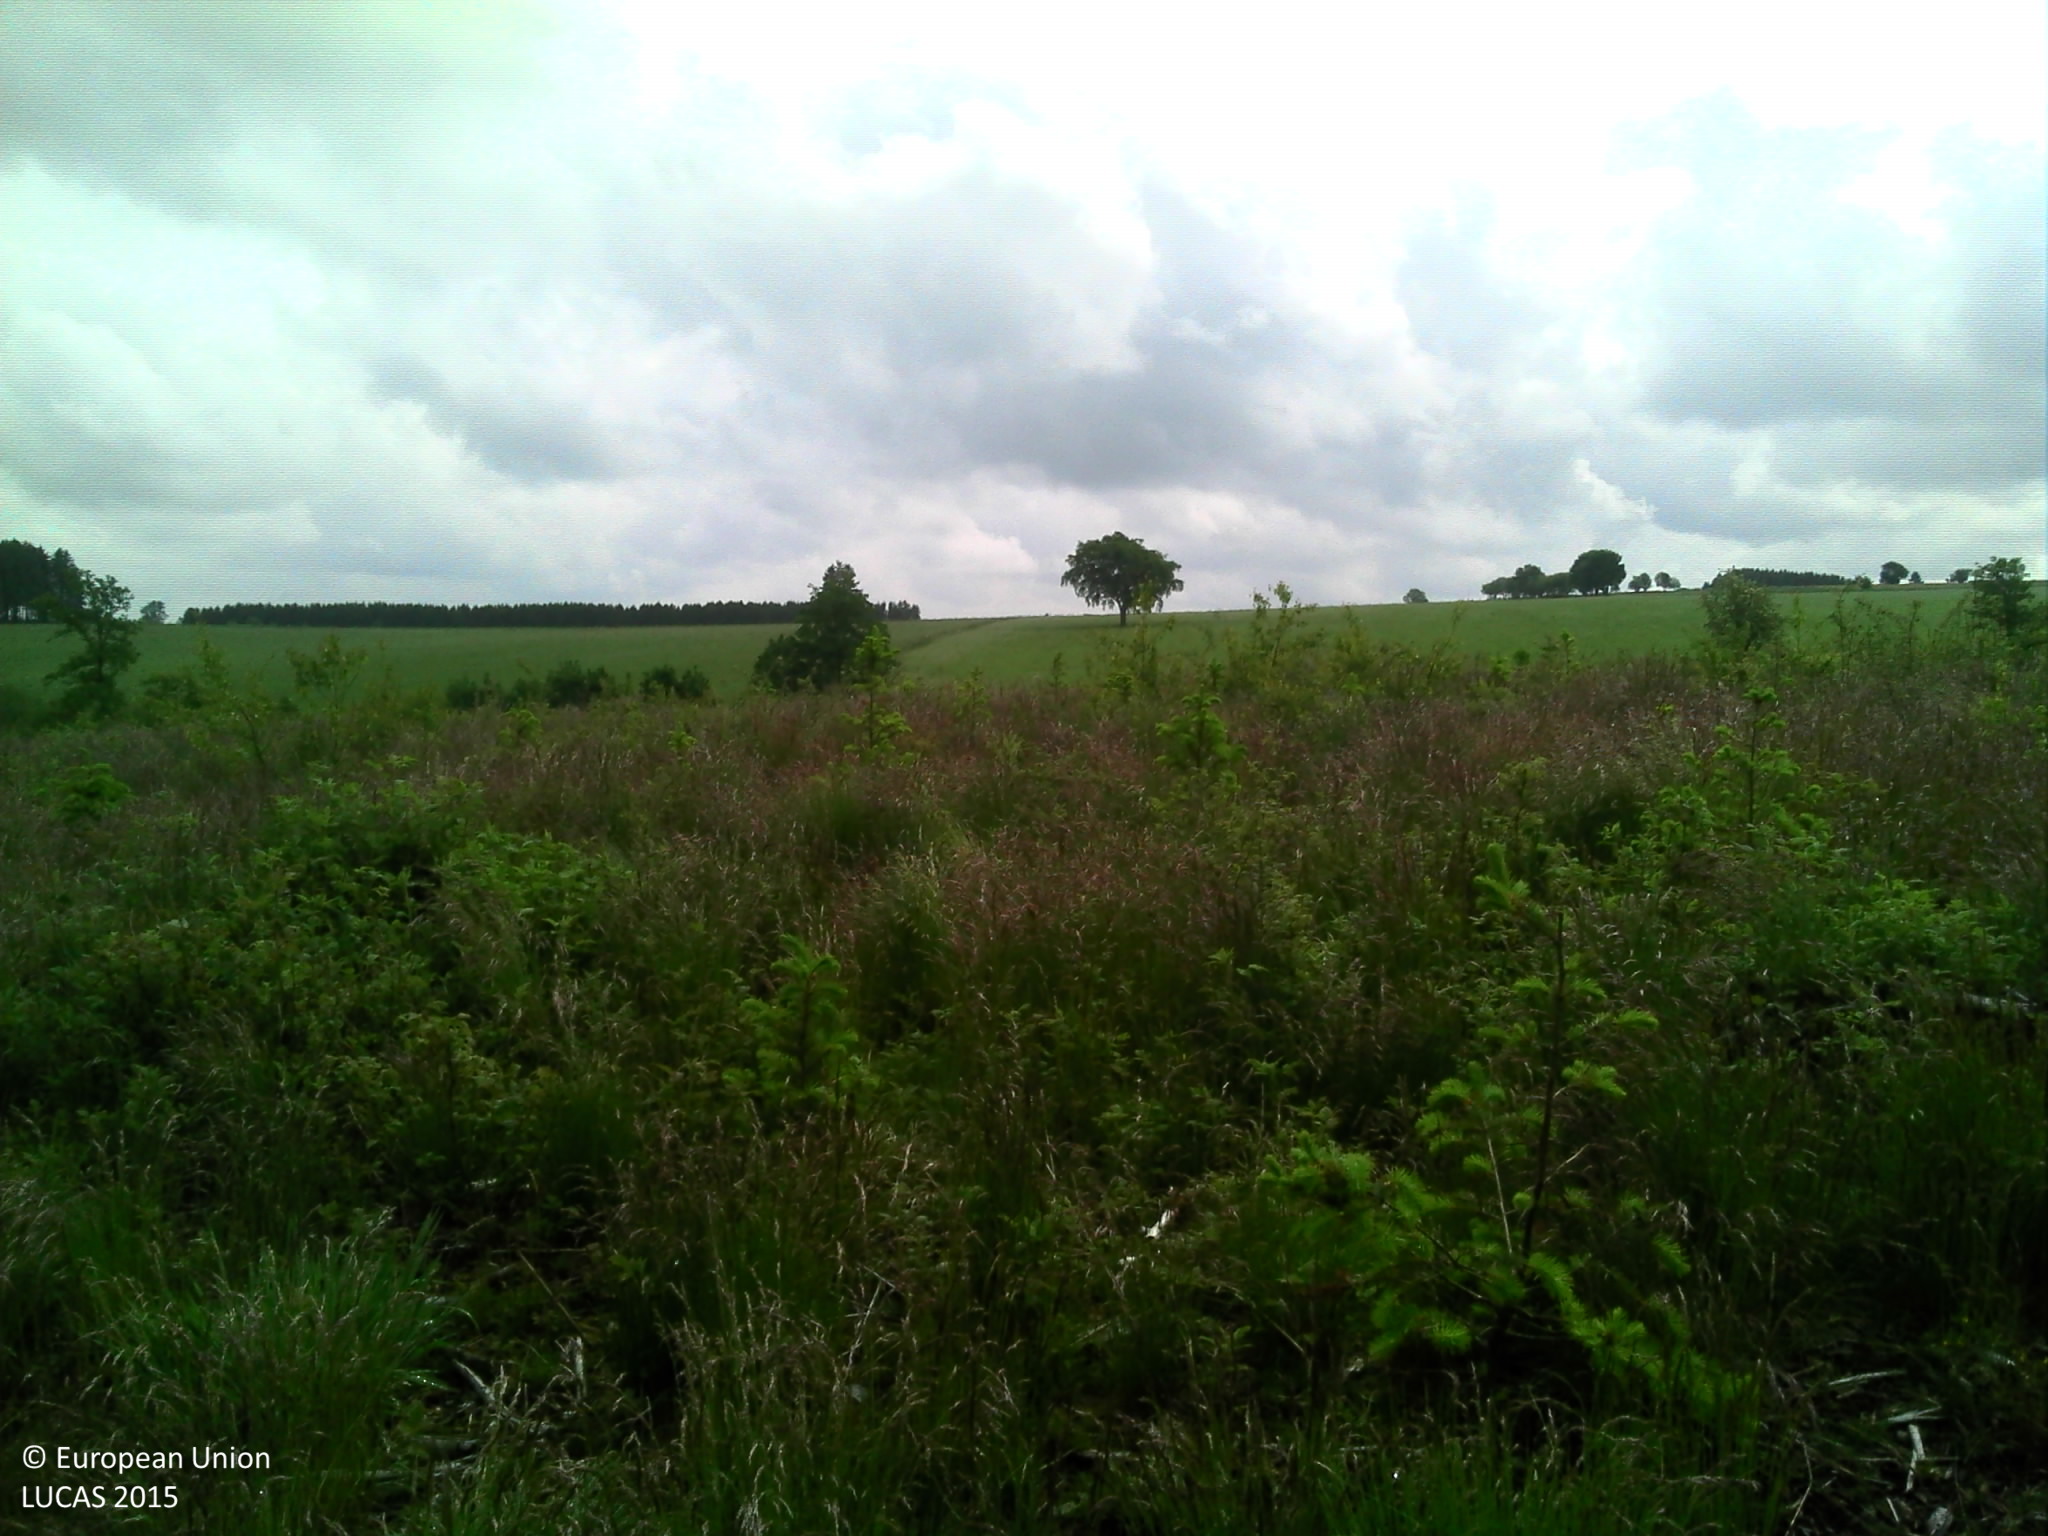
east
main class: Shrubland
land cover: Shrubland without tree cover
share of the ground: > 75 %
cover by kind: shrubs 60 %, herbaceous plants 40 %
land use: Forestry
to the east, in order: Shrubland without tree cover; Grass margins; Tracks; Nurseries; Broadleaved woodland; Grassland with sparse tree/shrub cover; Grass margins; Tracks; Grass margins; Fences; Grassland without tree/shrub cover
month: June
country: BE
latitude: 50.2681
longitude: 5.7758
